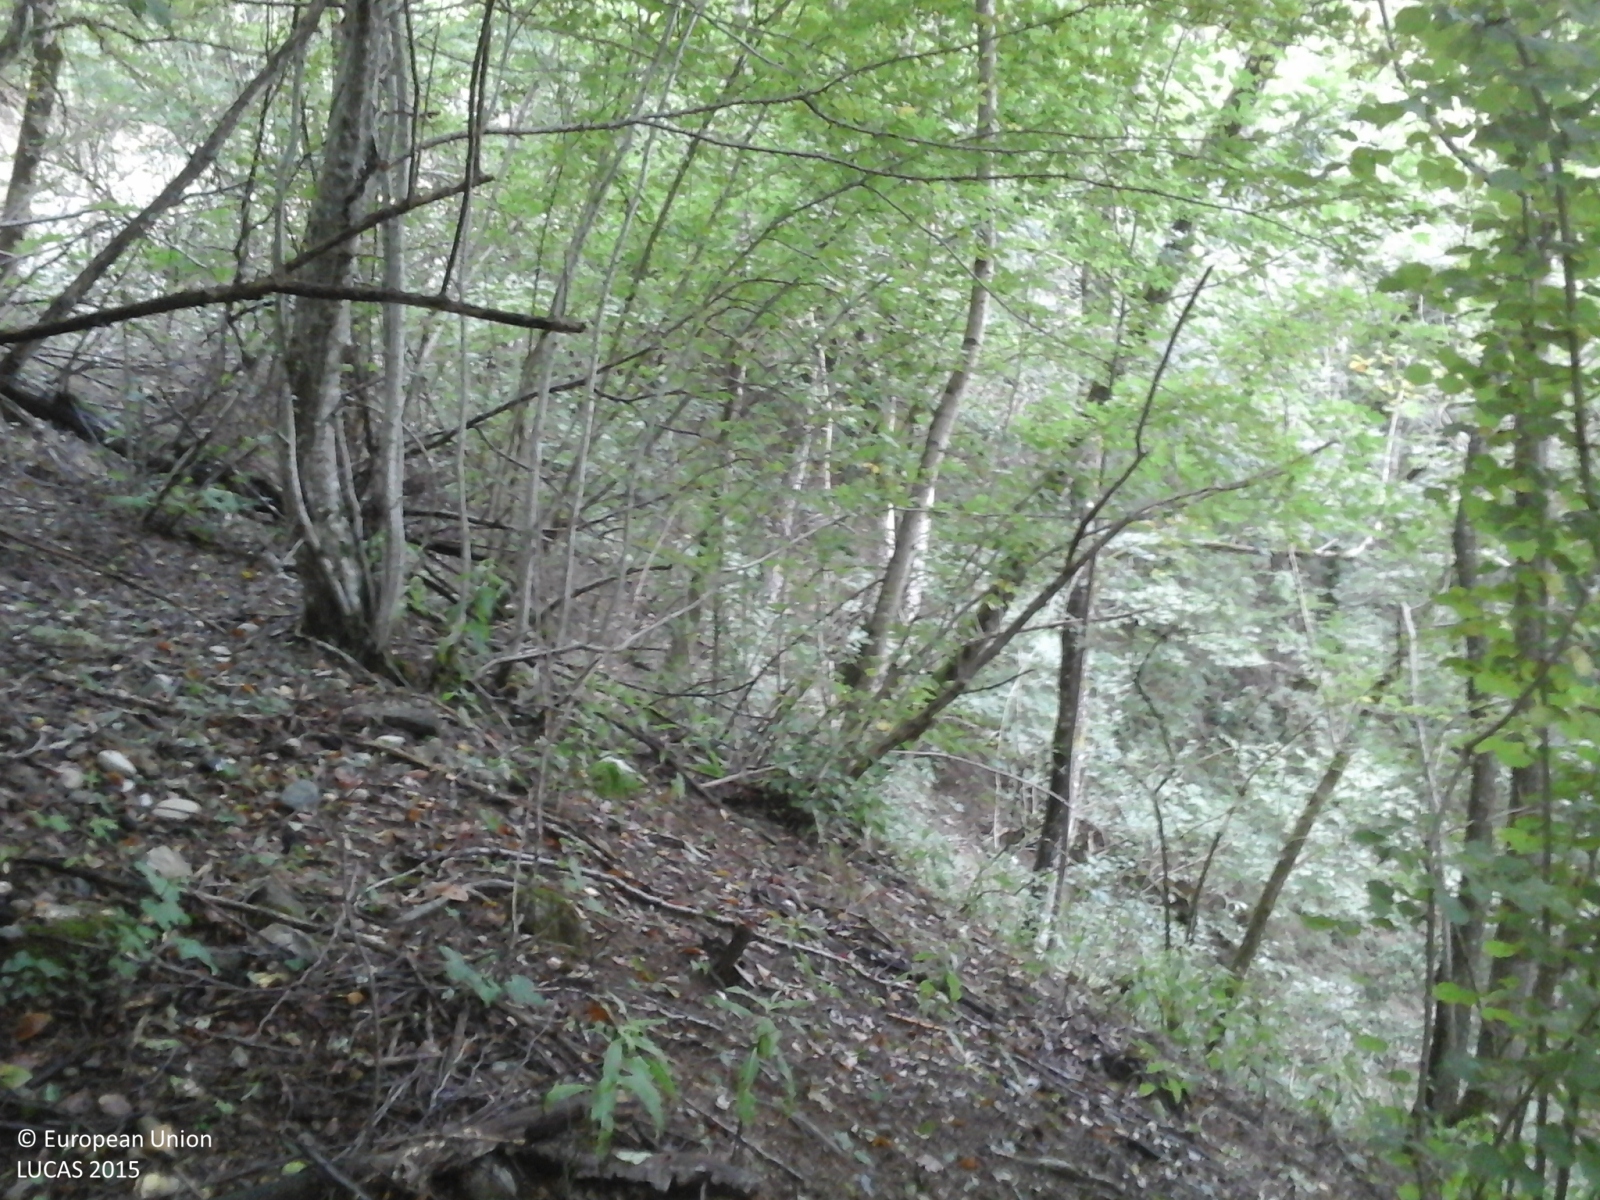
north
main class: Woodland
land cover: Broadleaved woodland
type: thermophilous deciduous forest
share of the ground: > 75 %
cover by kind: broadleaved forest trees 100 %
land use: Semi-natural and natural areas not in use
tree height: > 5 m
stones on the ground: 10 - 25 %
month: September
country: IT
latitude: 44.5099
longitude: 9.2093
